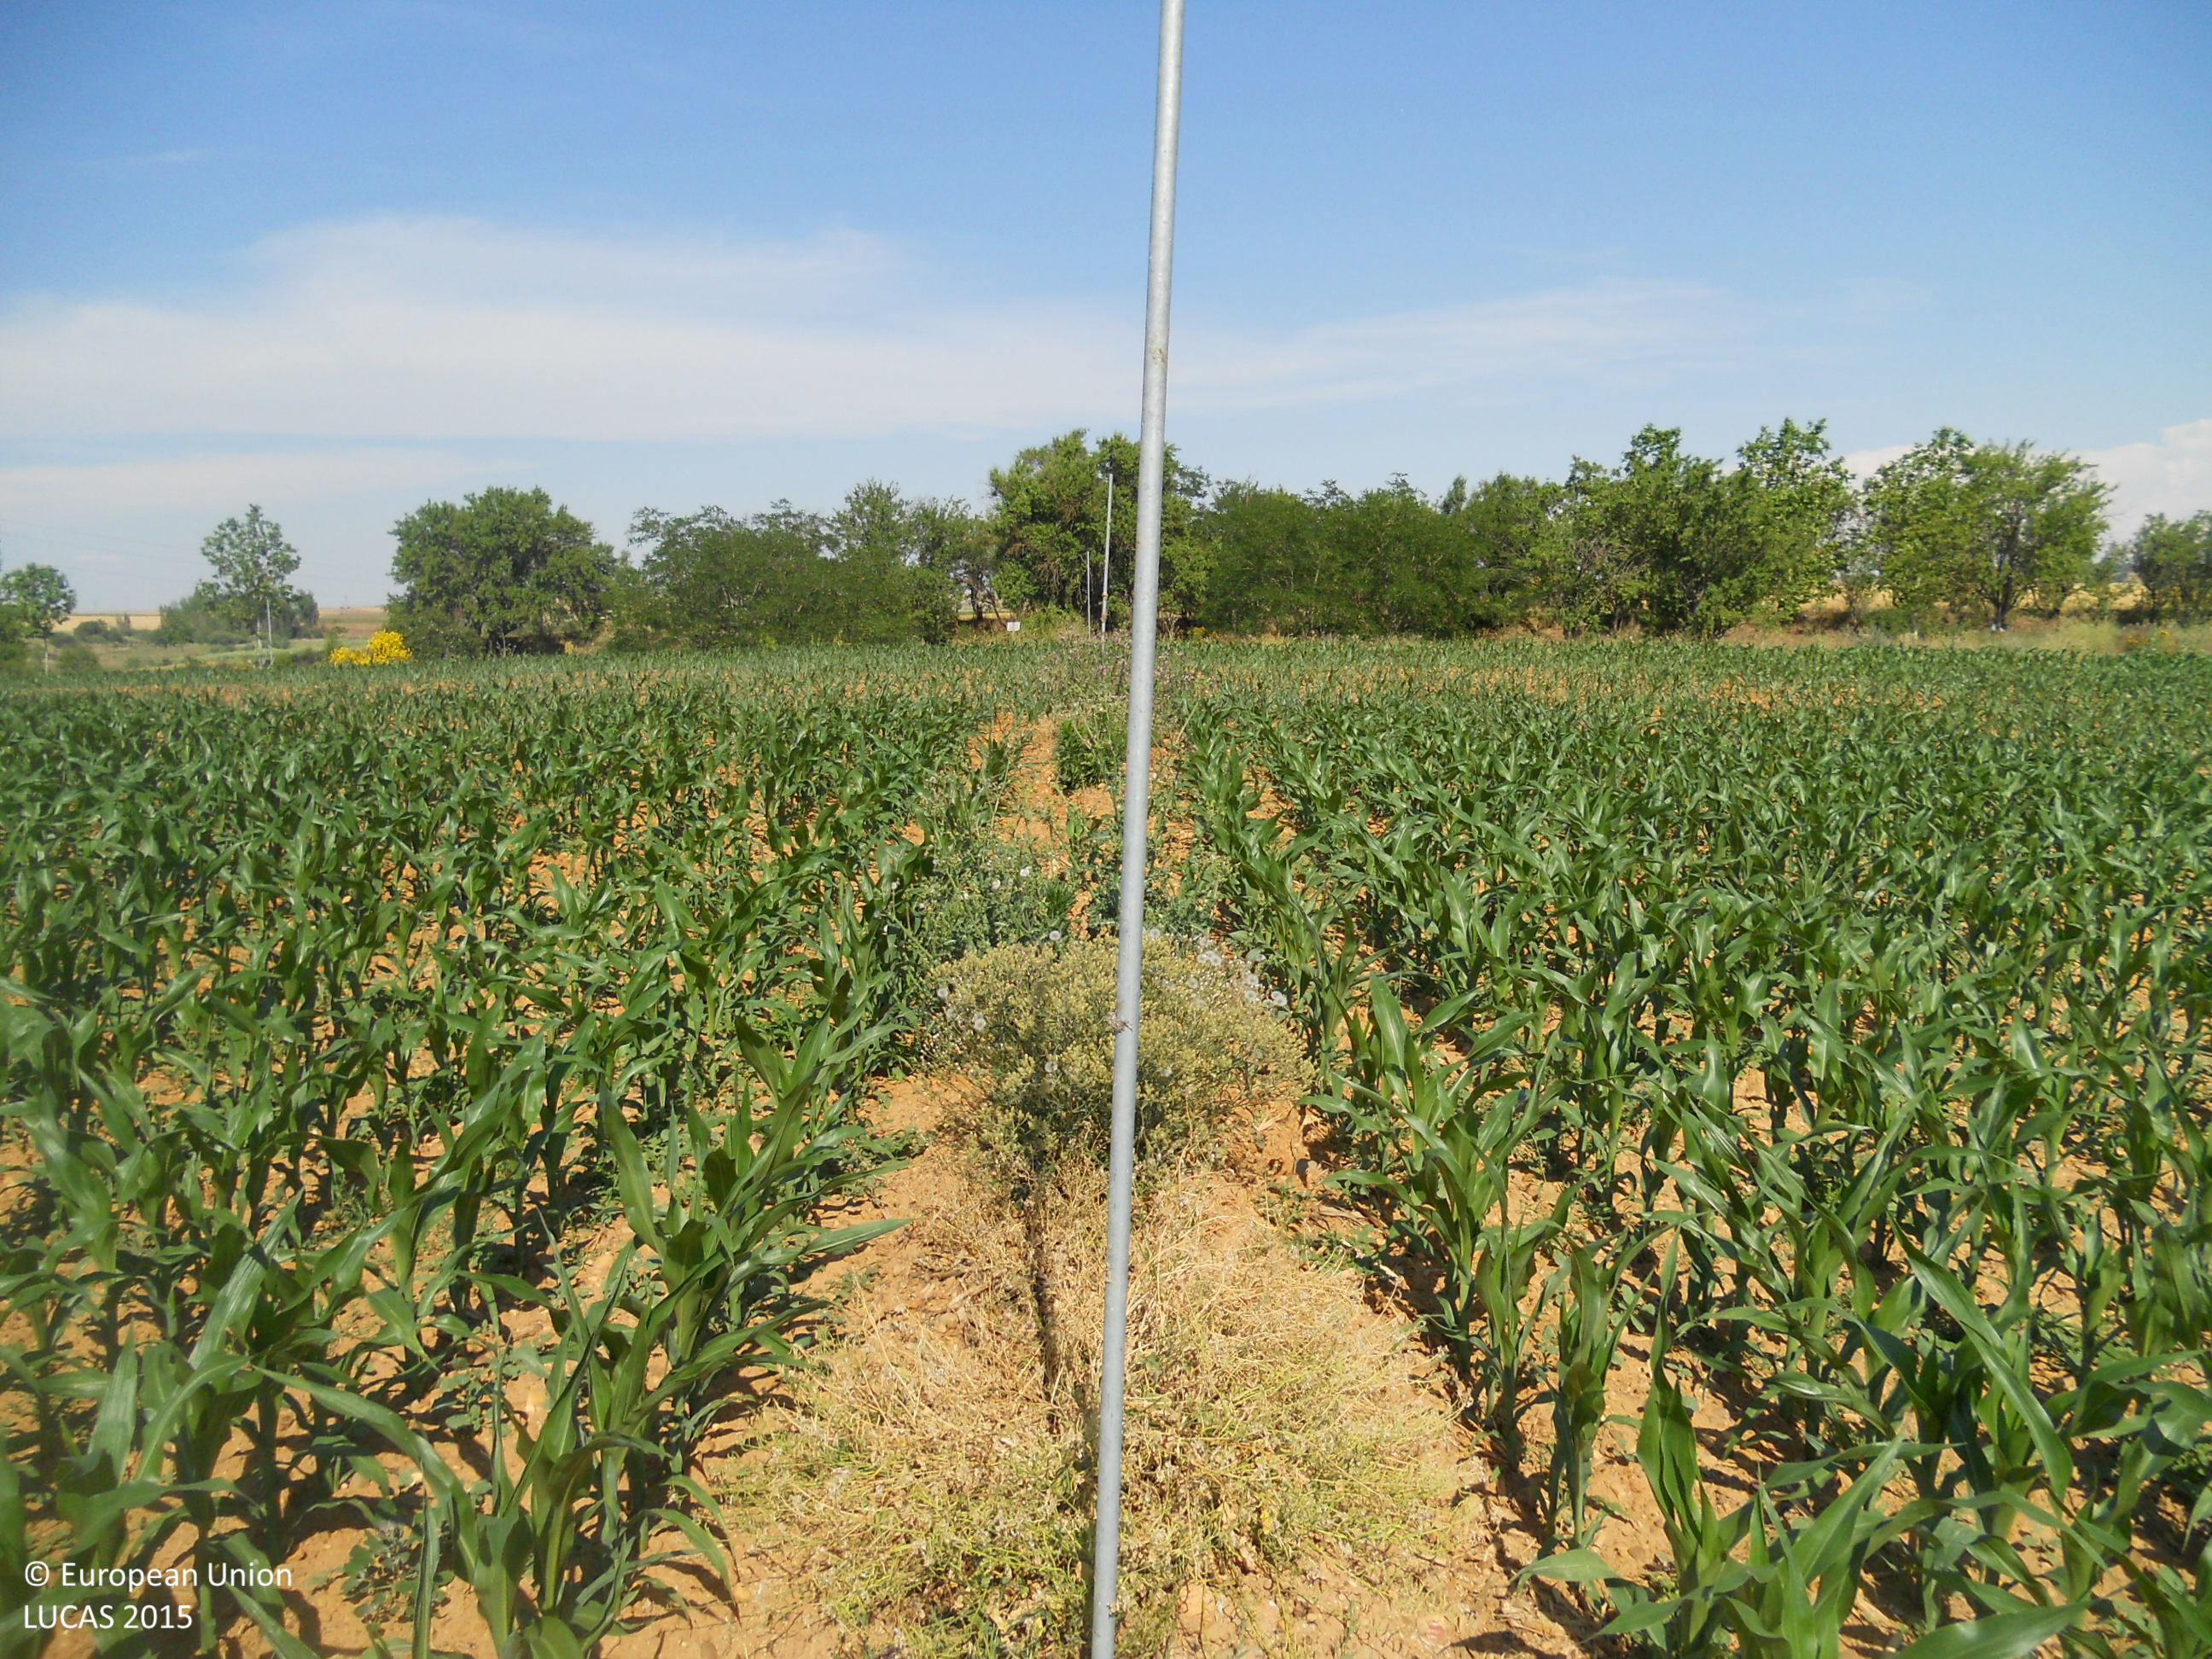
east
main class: Cropland
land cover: Maize
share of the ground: 10 - 25 %
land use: Agriculture (excluding fallow land and kitchen gardens)
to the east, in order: Maize; Grass margins; Tracks; Grass margins; Paved roads, cycling and walking lanes; Grassland with sparse tree/shrub cover; Groves; Grass margins; Tracks; Groves; Grass margins; Tracks; Grass margins; Barley
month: June
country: ES
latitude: 42.2565
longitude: -5.5227
